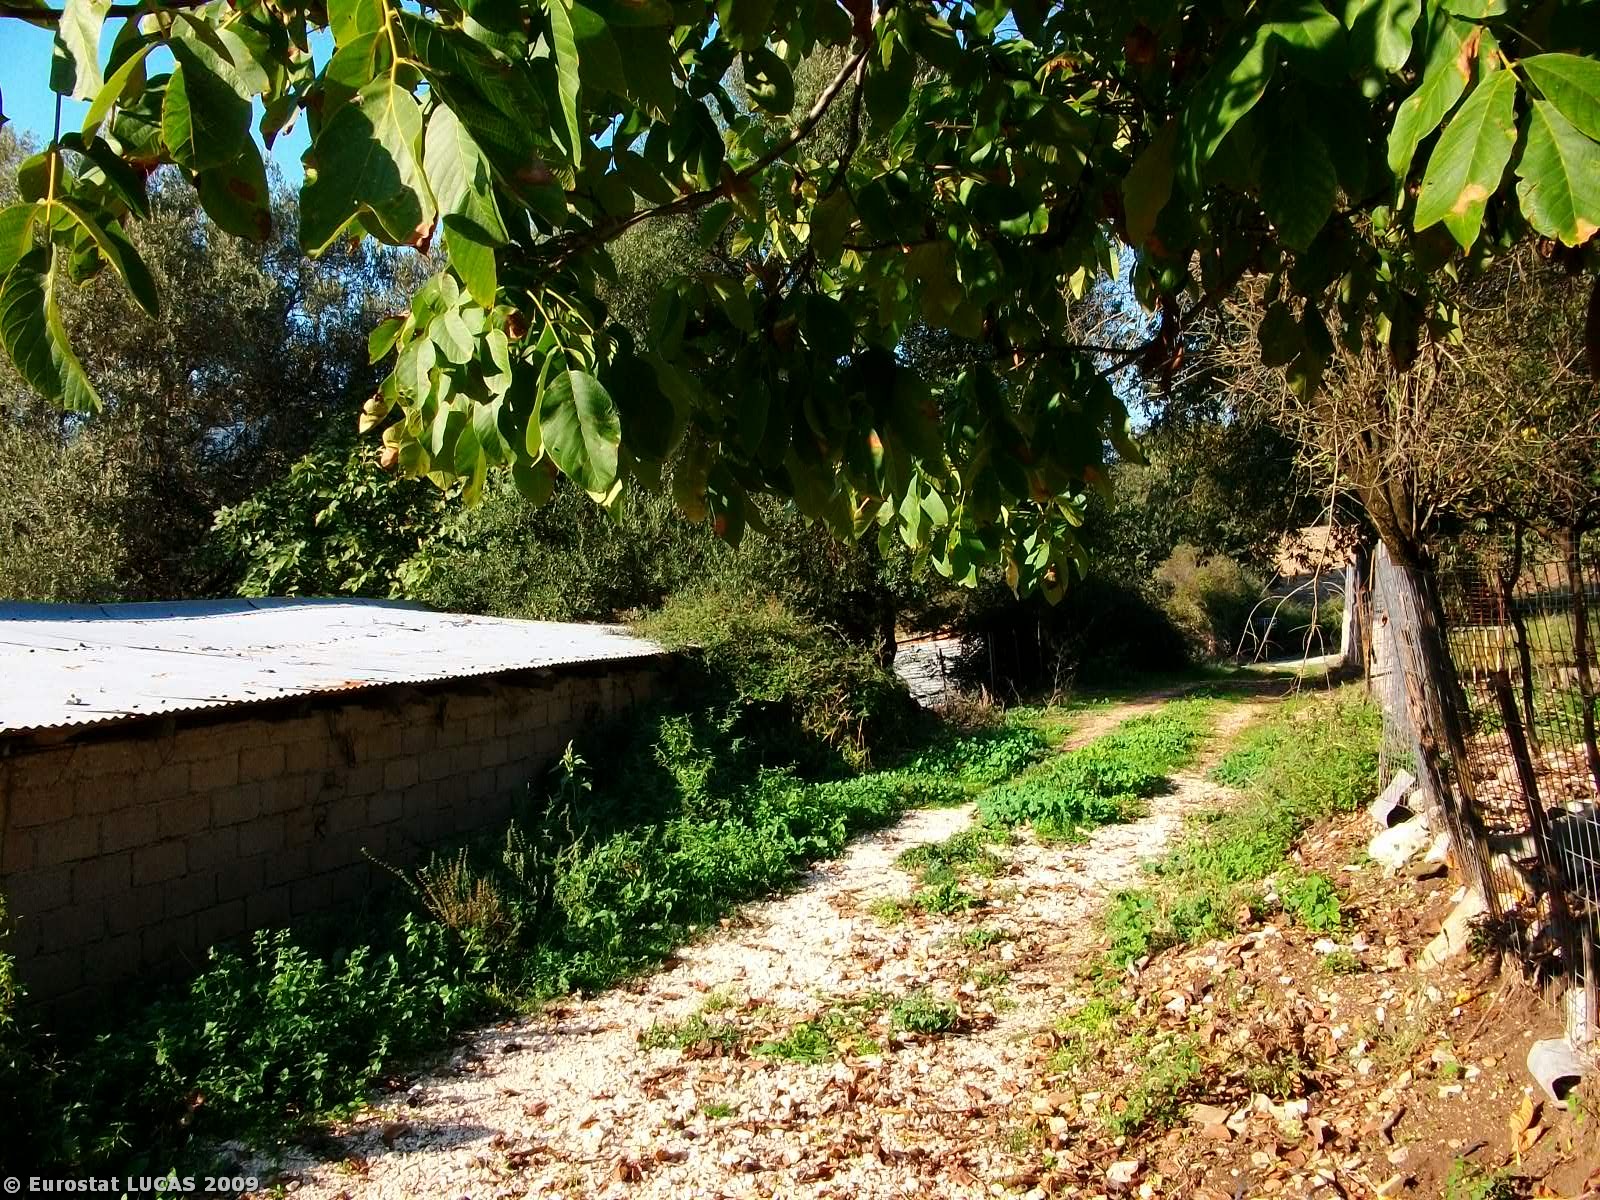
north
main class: Cropland
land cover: Nuts trees
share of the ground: 25 - 50 %
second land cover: Bare land
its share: > 75 %
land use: Kitchen garden
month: October
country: GR
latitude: 39.3942
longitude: 20.4820
